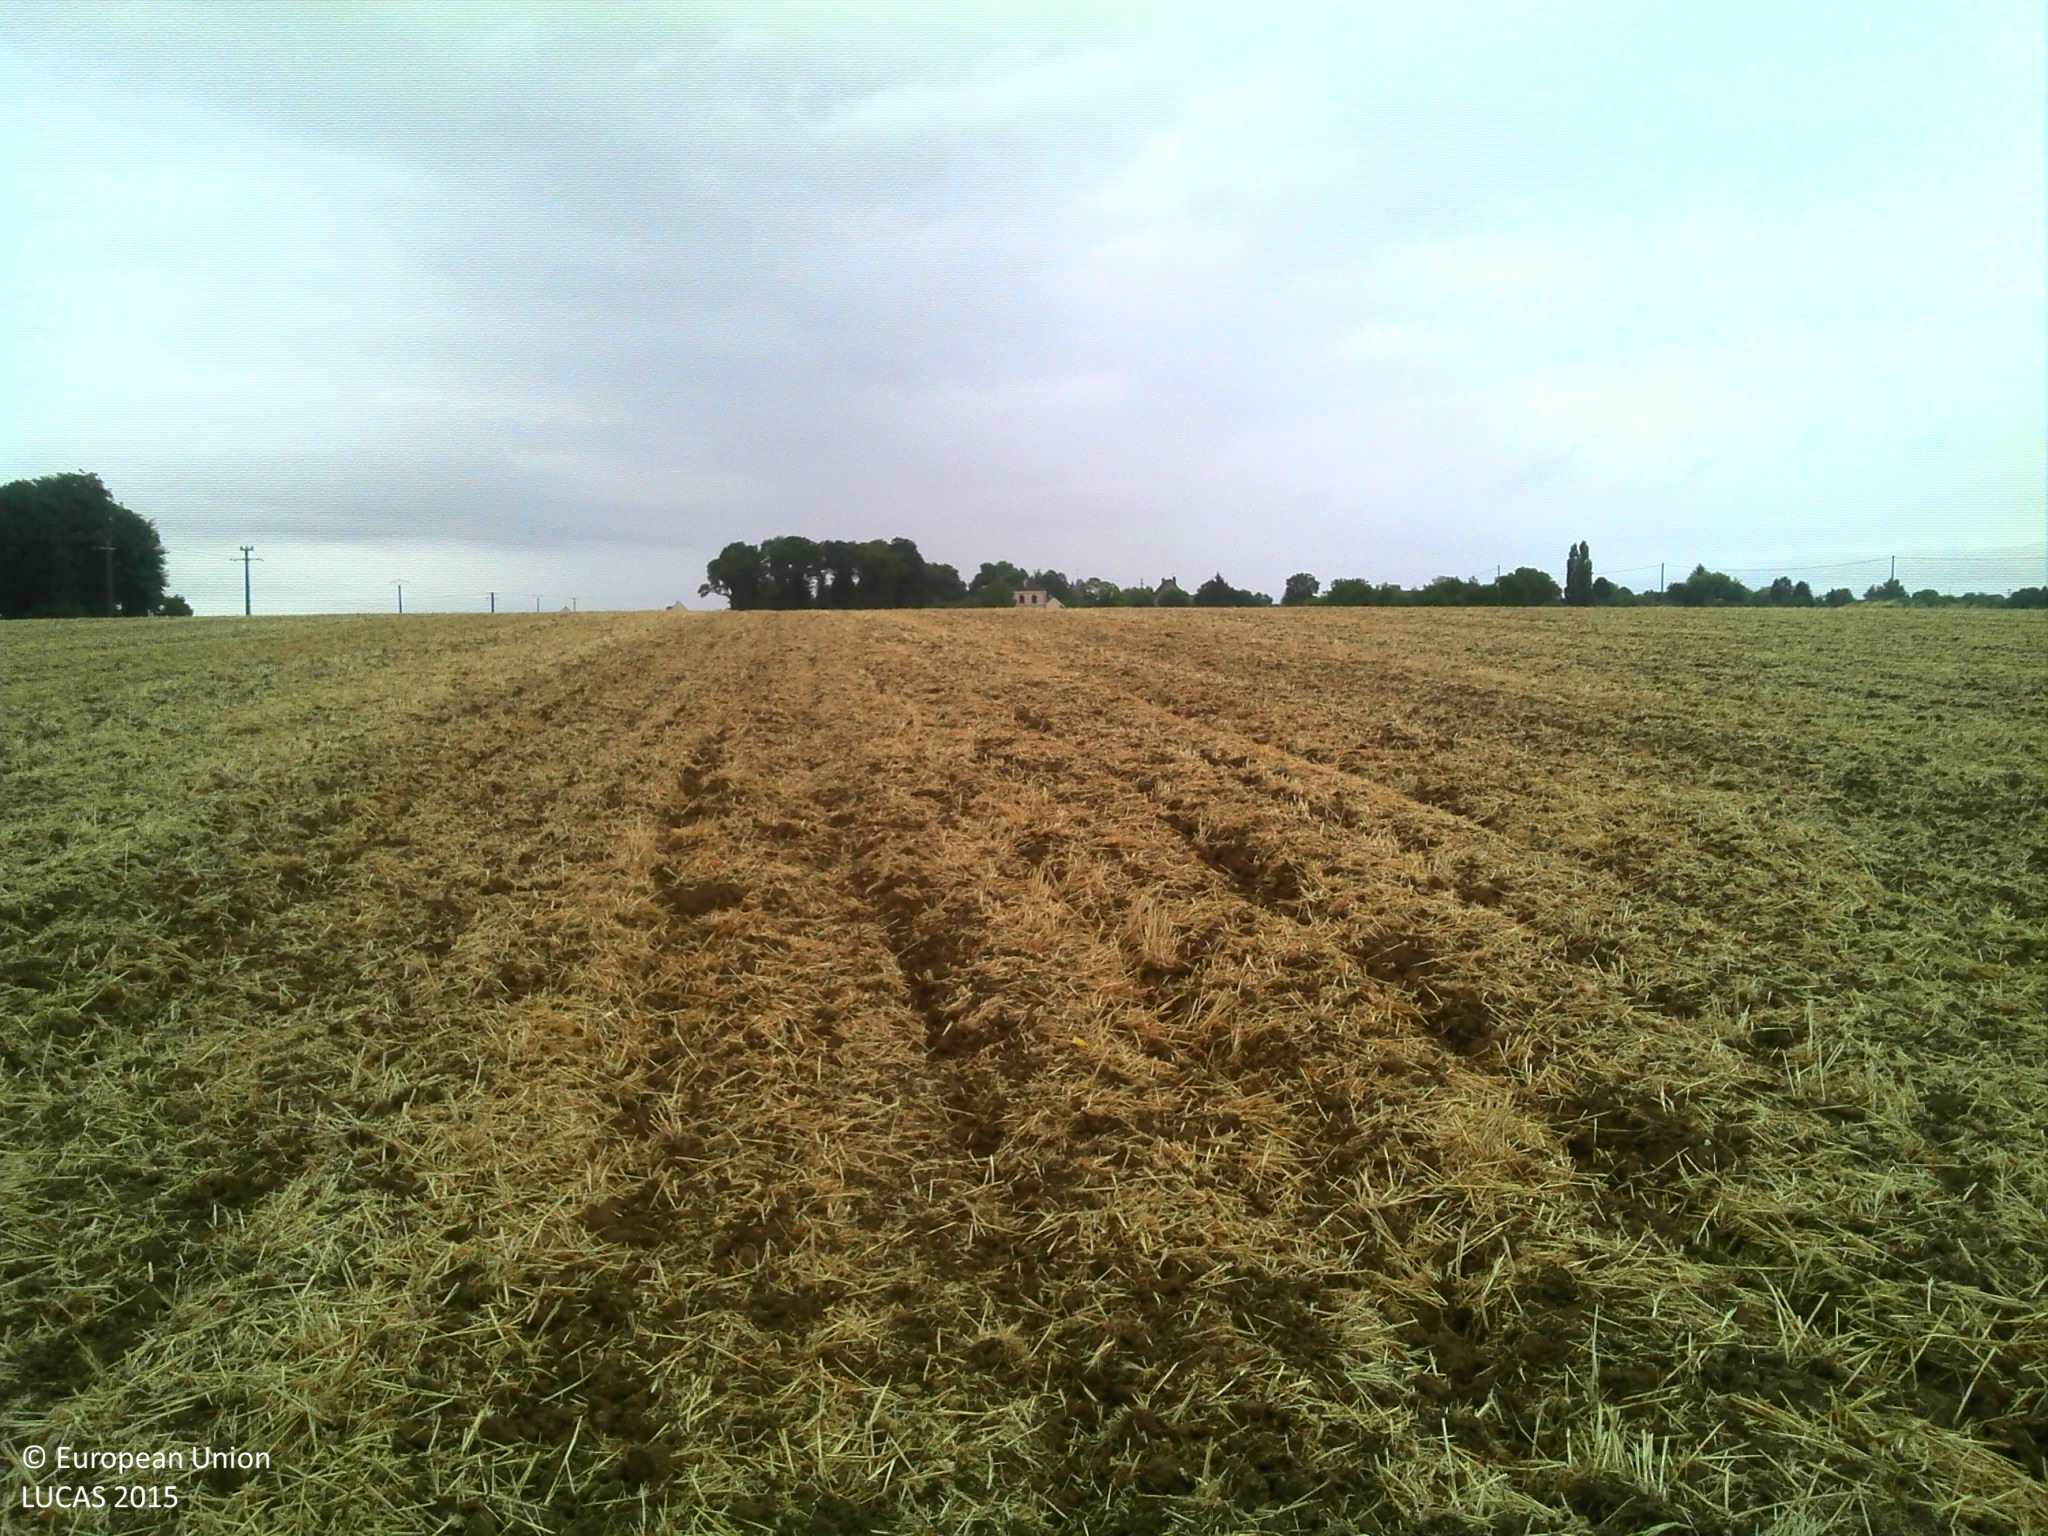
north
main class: Cropland
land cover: Common wheat
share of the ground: > 75 %
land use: Agriculture (excluding fallow land and kitchen gardens)
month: August
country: FR
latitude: 48.5279
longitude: 3.3446
